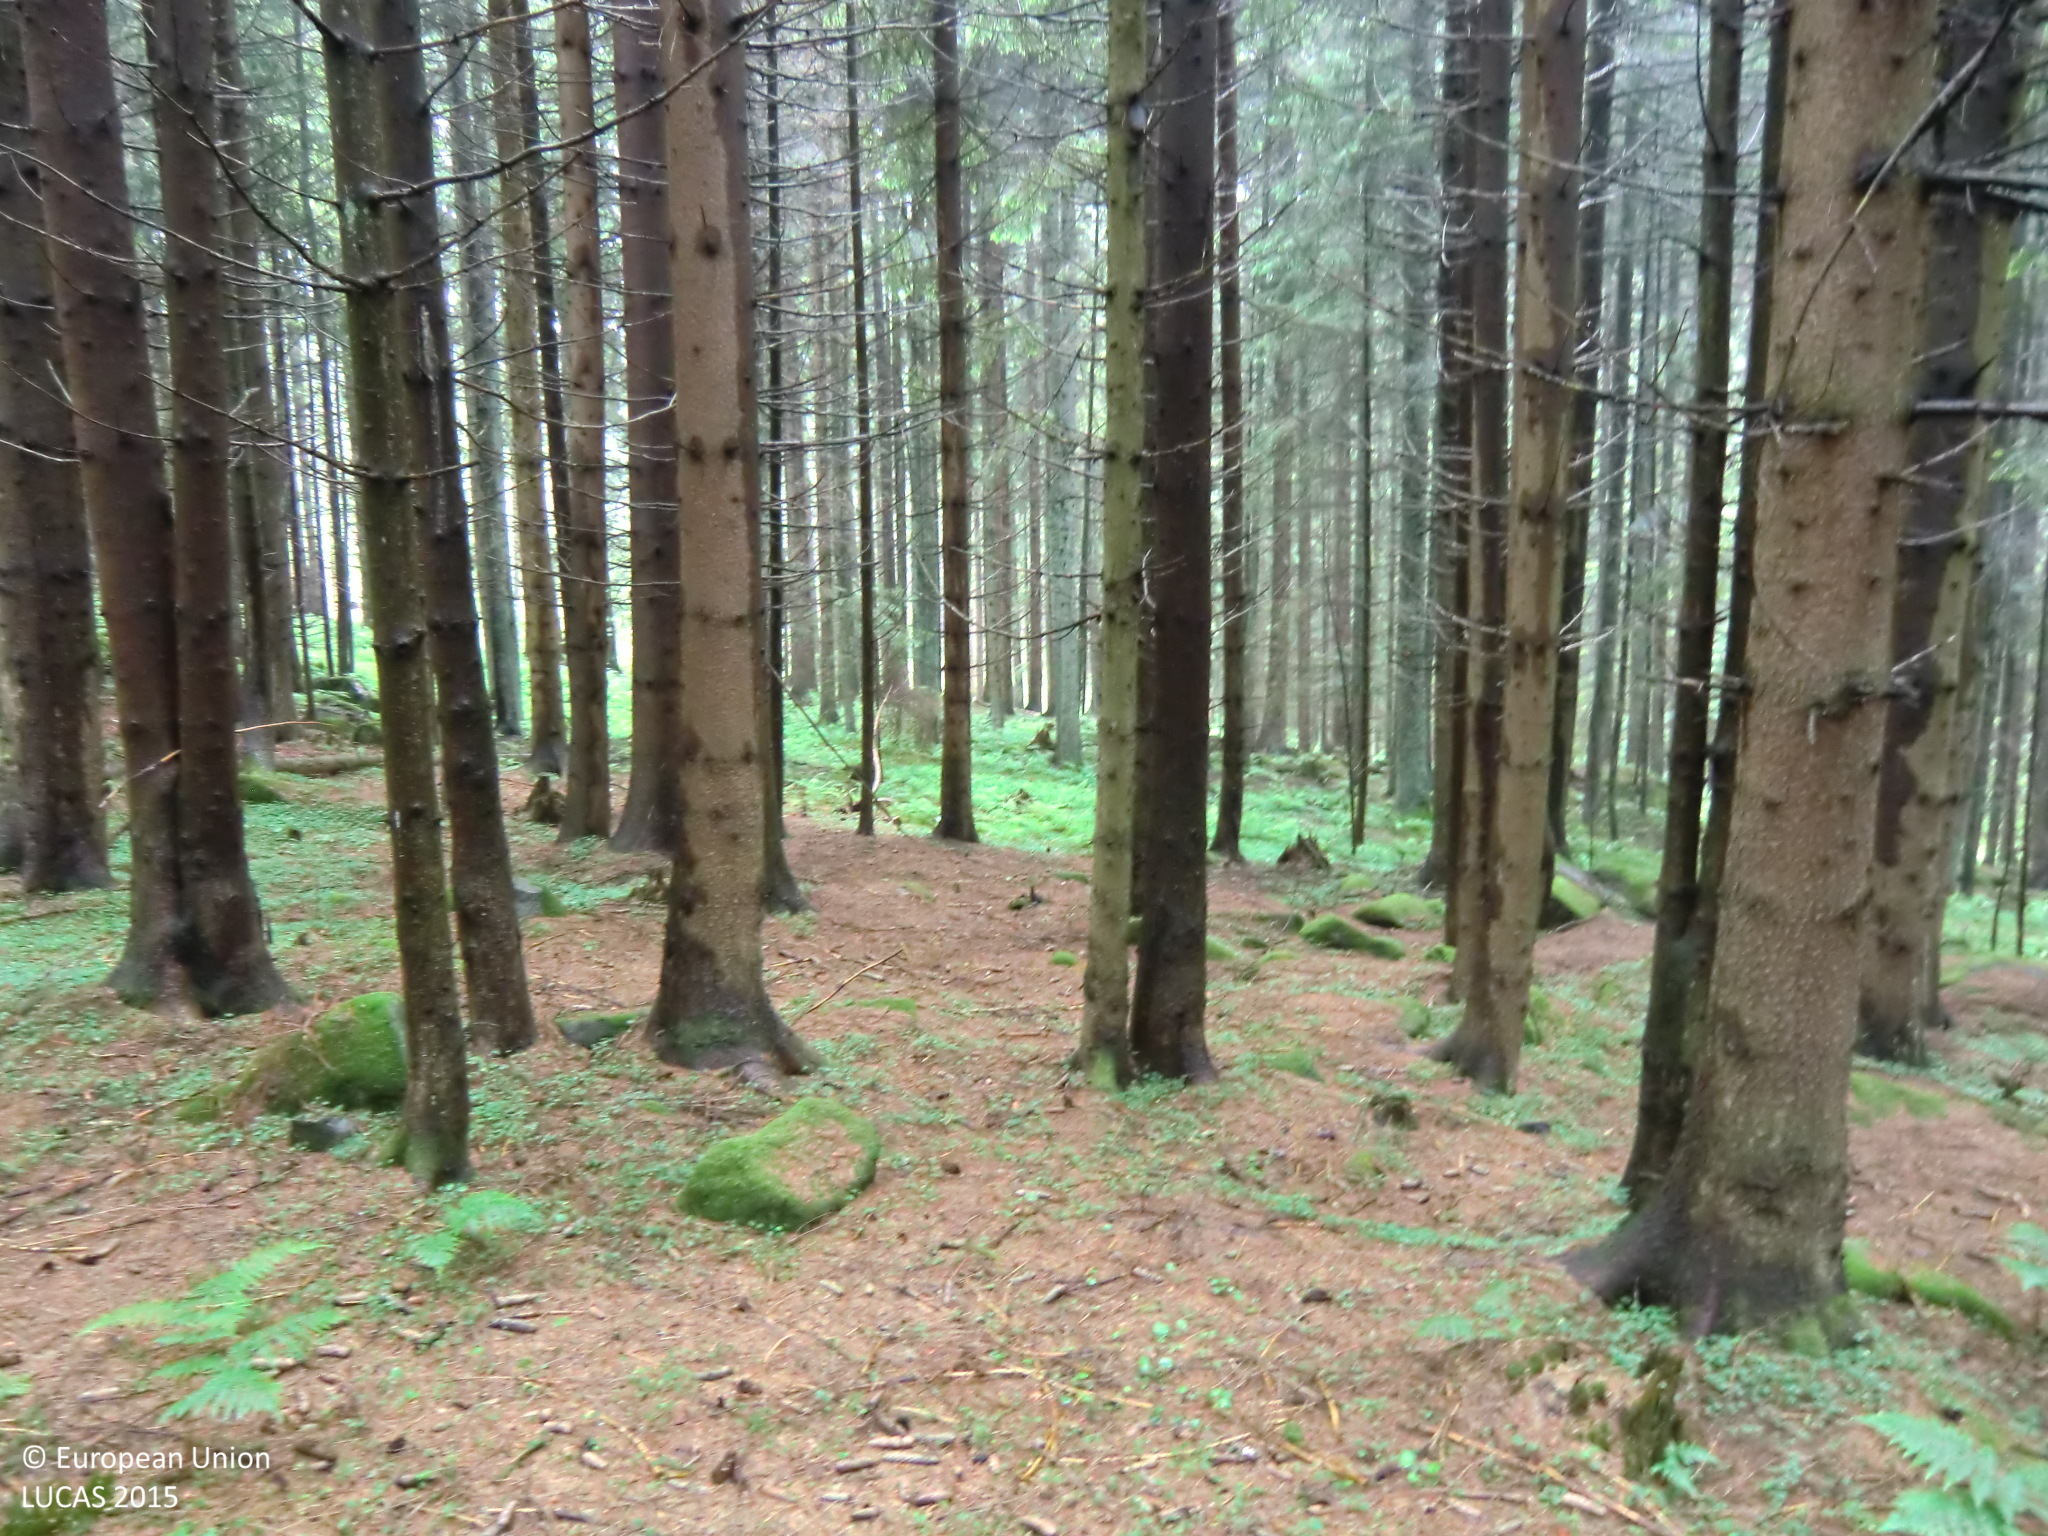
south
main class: Woodland
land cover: Spruce dominated coniferous woodland
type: hemiboreal forest and nemoral coniferous forest and mixed broadleaved-coniferous forest
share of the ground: > 75 %
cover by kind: coniferous forest trees 75 %, unconsolidated bare surface 15 %, herbaceous plants 10 %
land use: Forestry
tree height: > 5 m
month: June
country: AT
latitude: 48.5244
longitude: 14.5910
